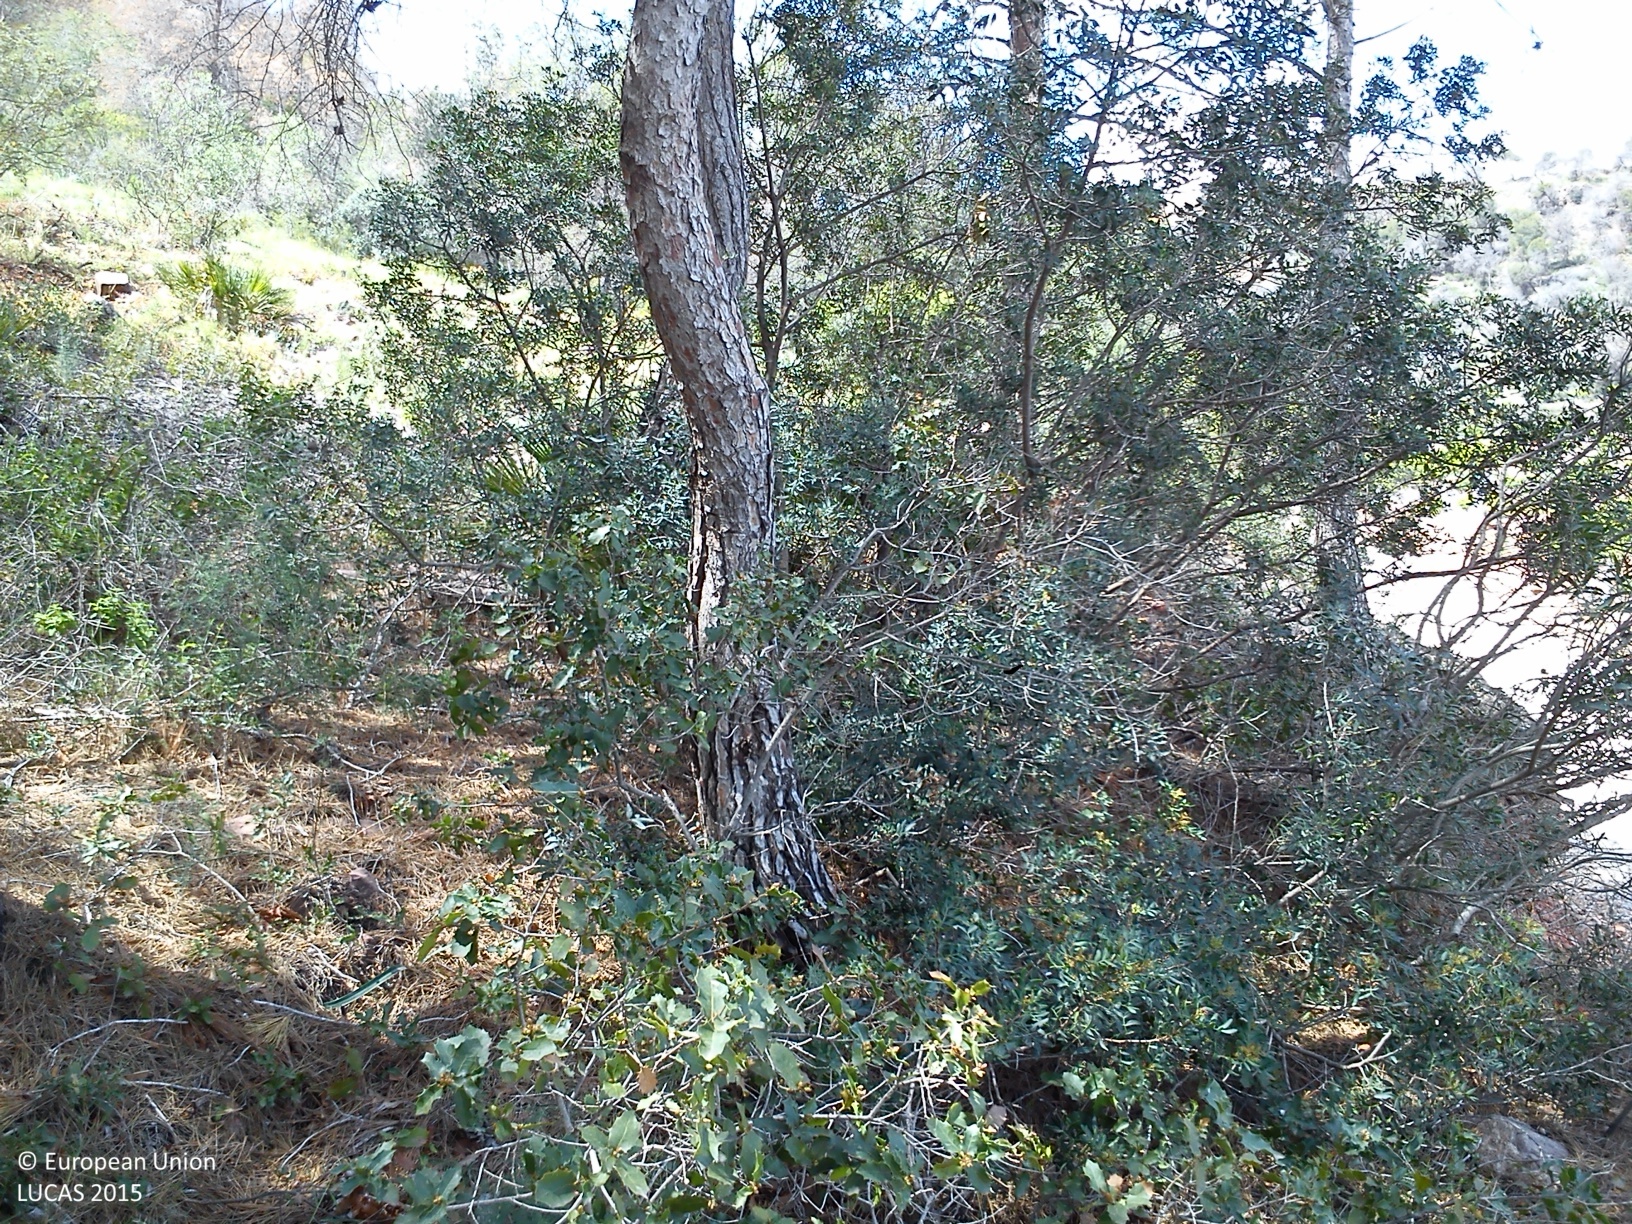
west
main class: Woodland
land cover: Pine dominated coniferous woodland
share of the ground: > 75 %
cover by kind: coniferous forest trees 85 %, shrubs 10 %, herbaceous plants 5 %
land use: Forestry
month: April
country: ES
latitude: 39.5455
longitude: -0.6000
